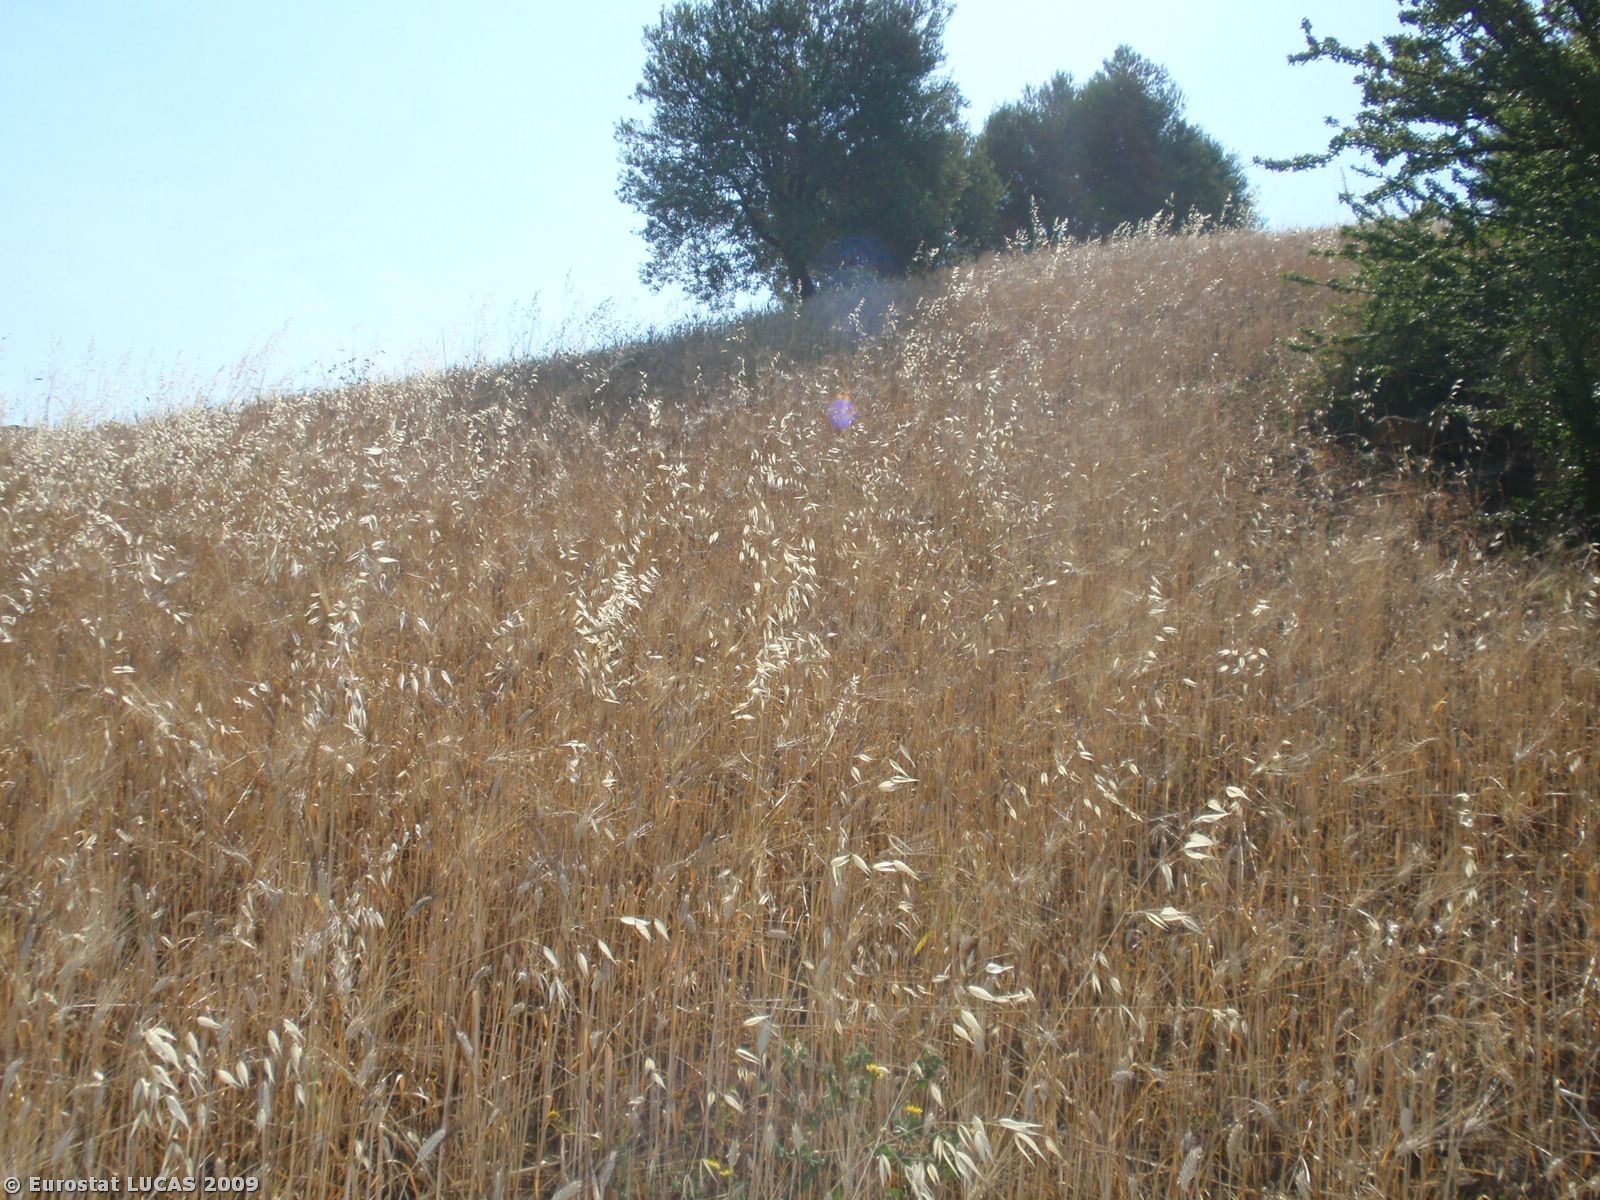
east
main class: Shrubland
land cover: Shrubland without tree cover
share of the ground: > 75 %
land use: Unused
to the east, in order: Shrubland without tree cover; Durum wheat; Olive groves; Durum wheat; Olive groves; Durum wheat; Spontaneously vegetated surfaces; Shrubland without tree cover
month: June
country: IT
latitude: 40.1220
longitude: 16.5332
